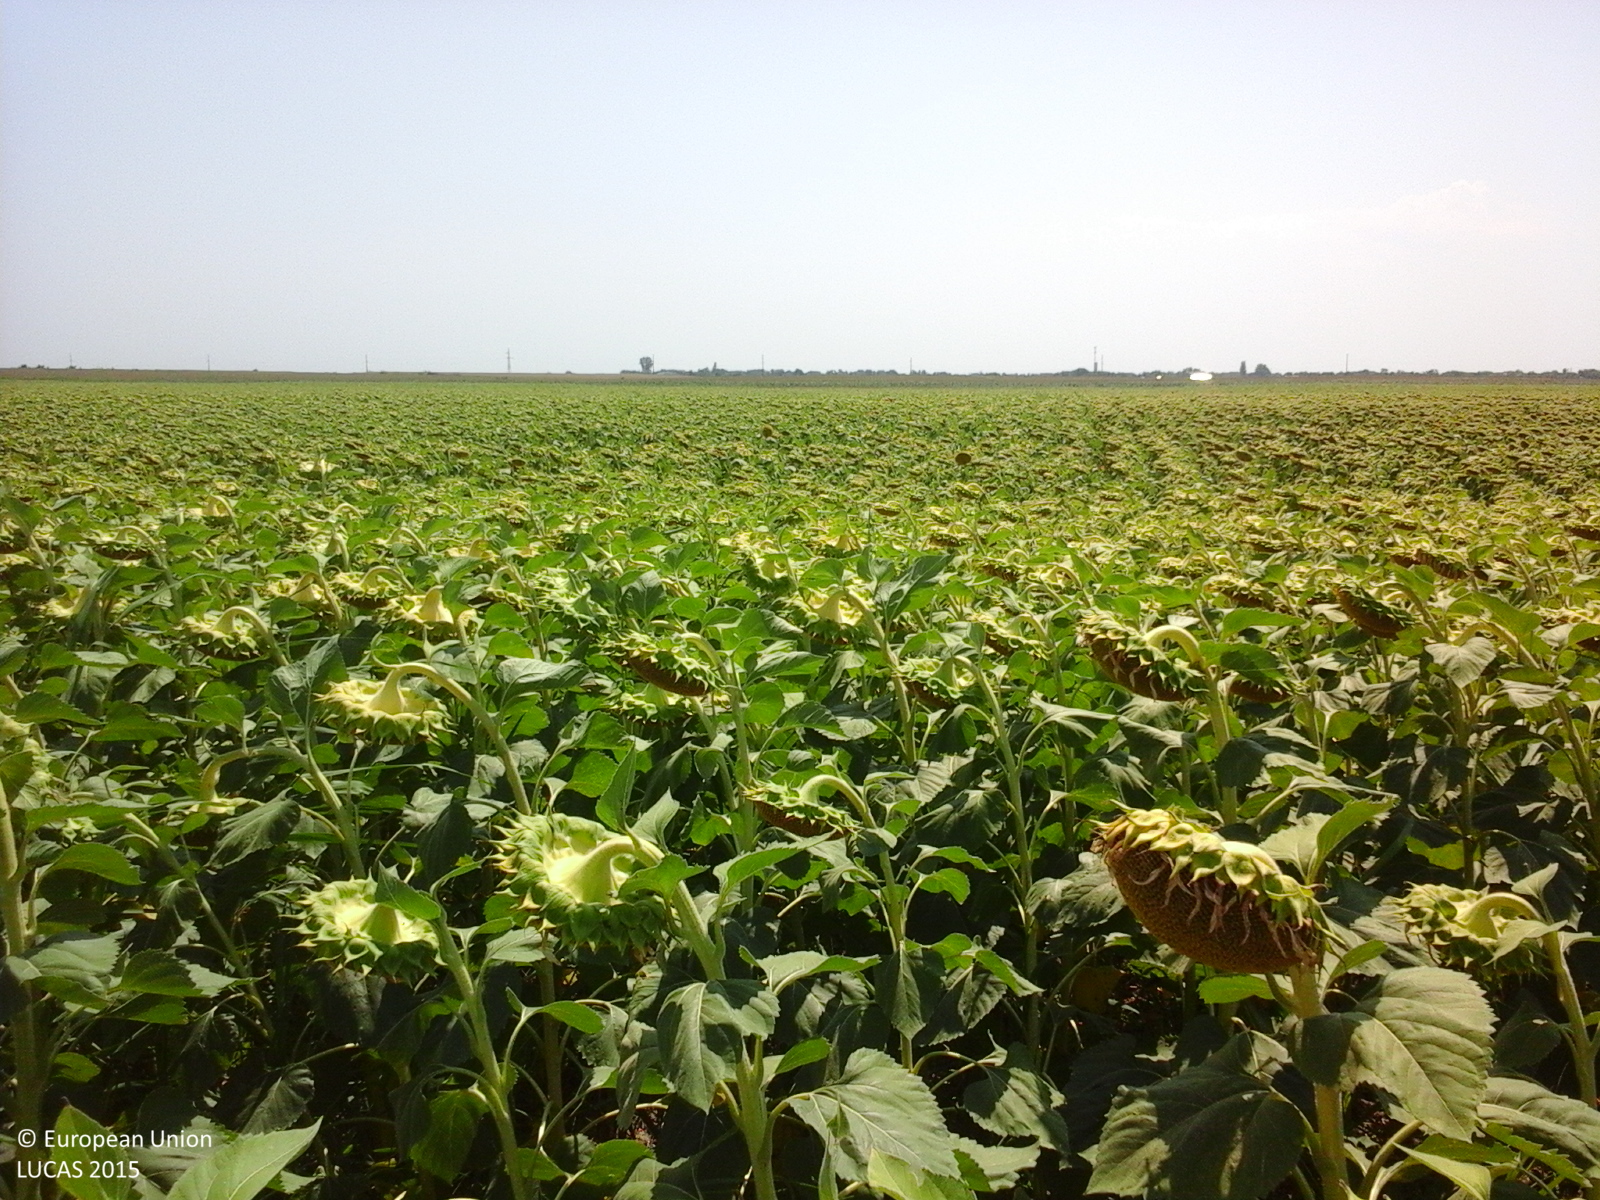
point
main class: Cropland
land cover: Sunflower
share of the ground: > 75 %
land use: Agriculture (excluding fallow land and kitchen gardens)
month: August
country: RO
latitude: 45.3121
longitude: 27.7487
